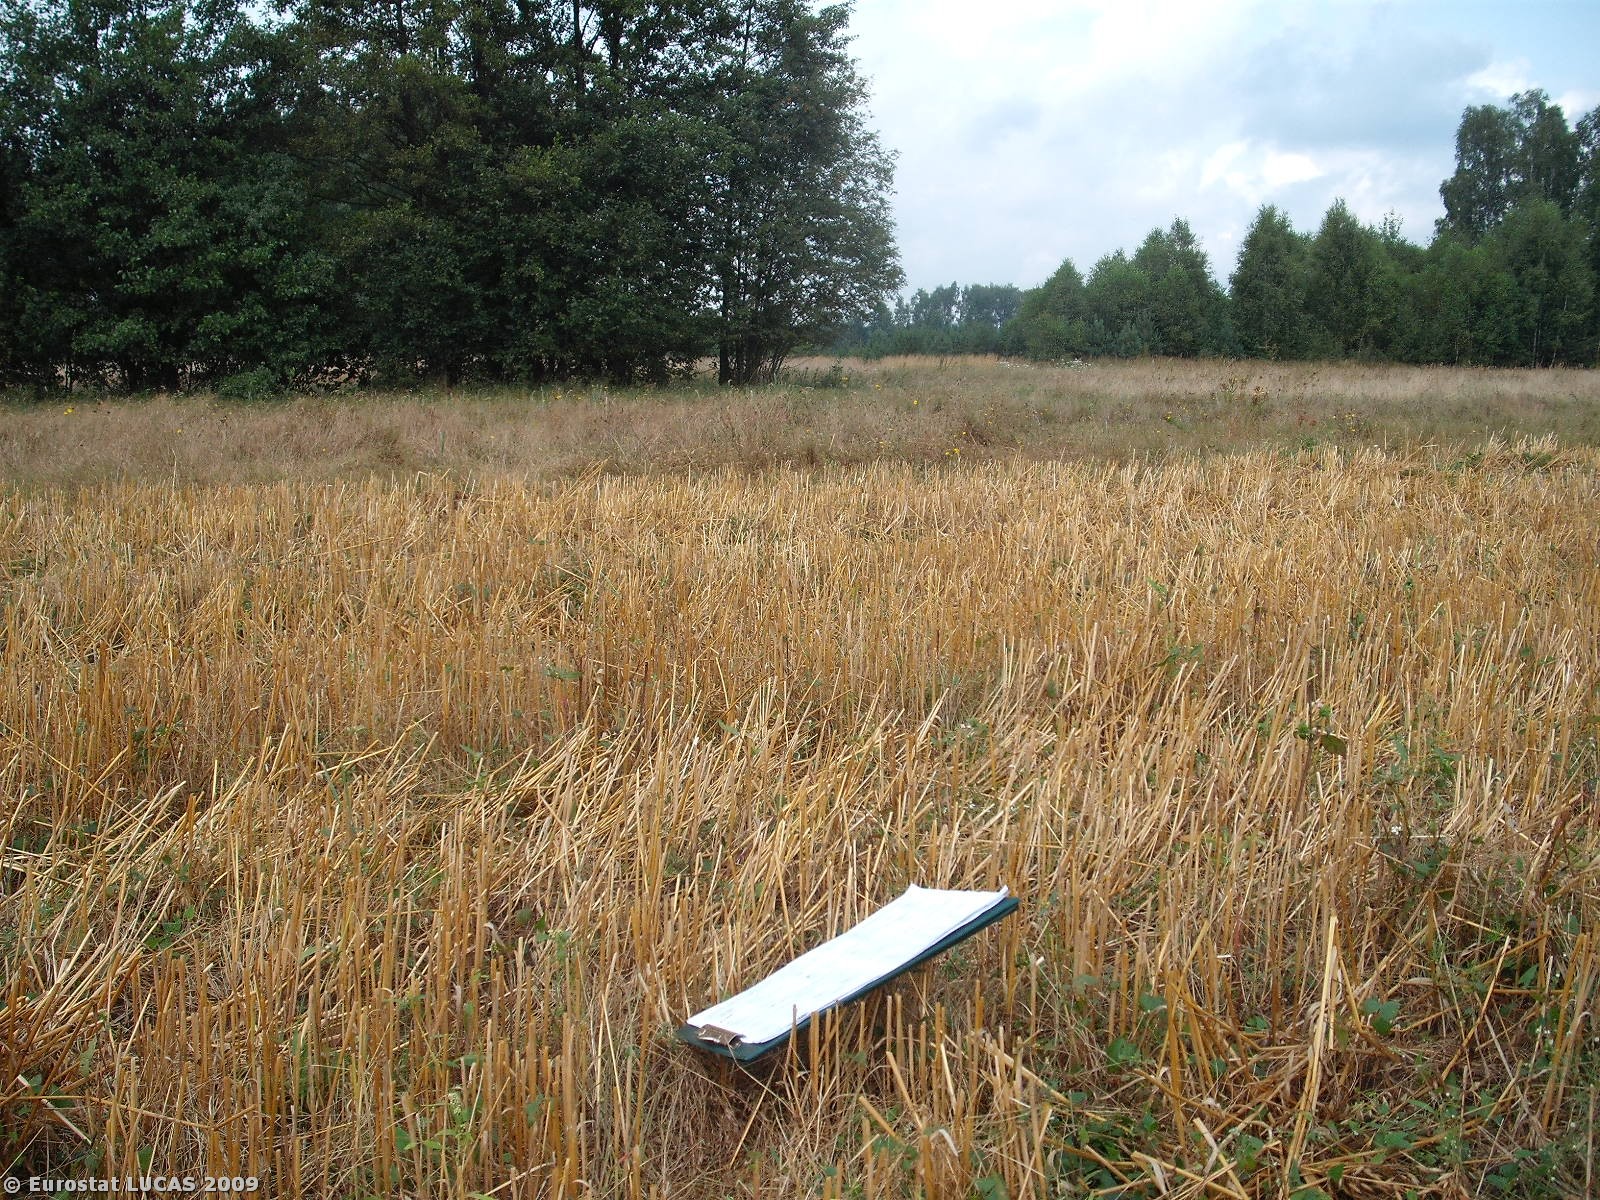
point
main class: Cropland
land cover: Rye
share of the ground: < 10 %
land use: Agriculture (excluding fallow land and kitchen gardens)
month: August
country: PL
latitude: 52.4190
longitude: 21.6544
